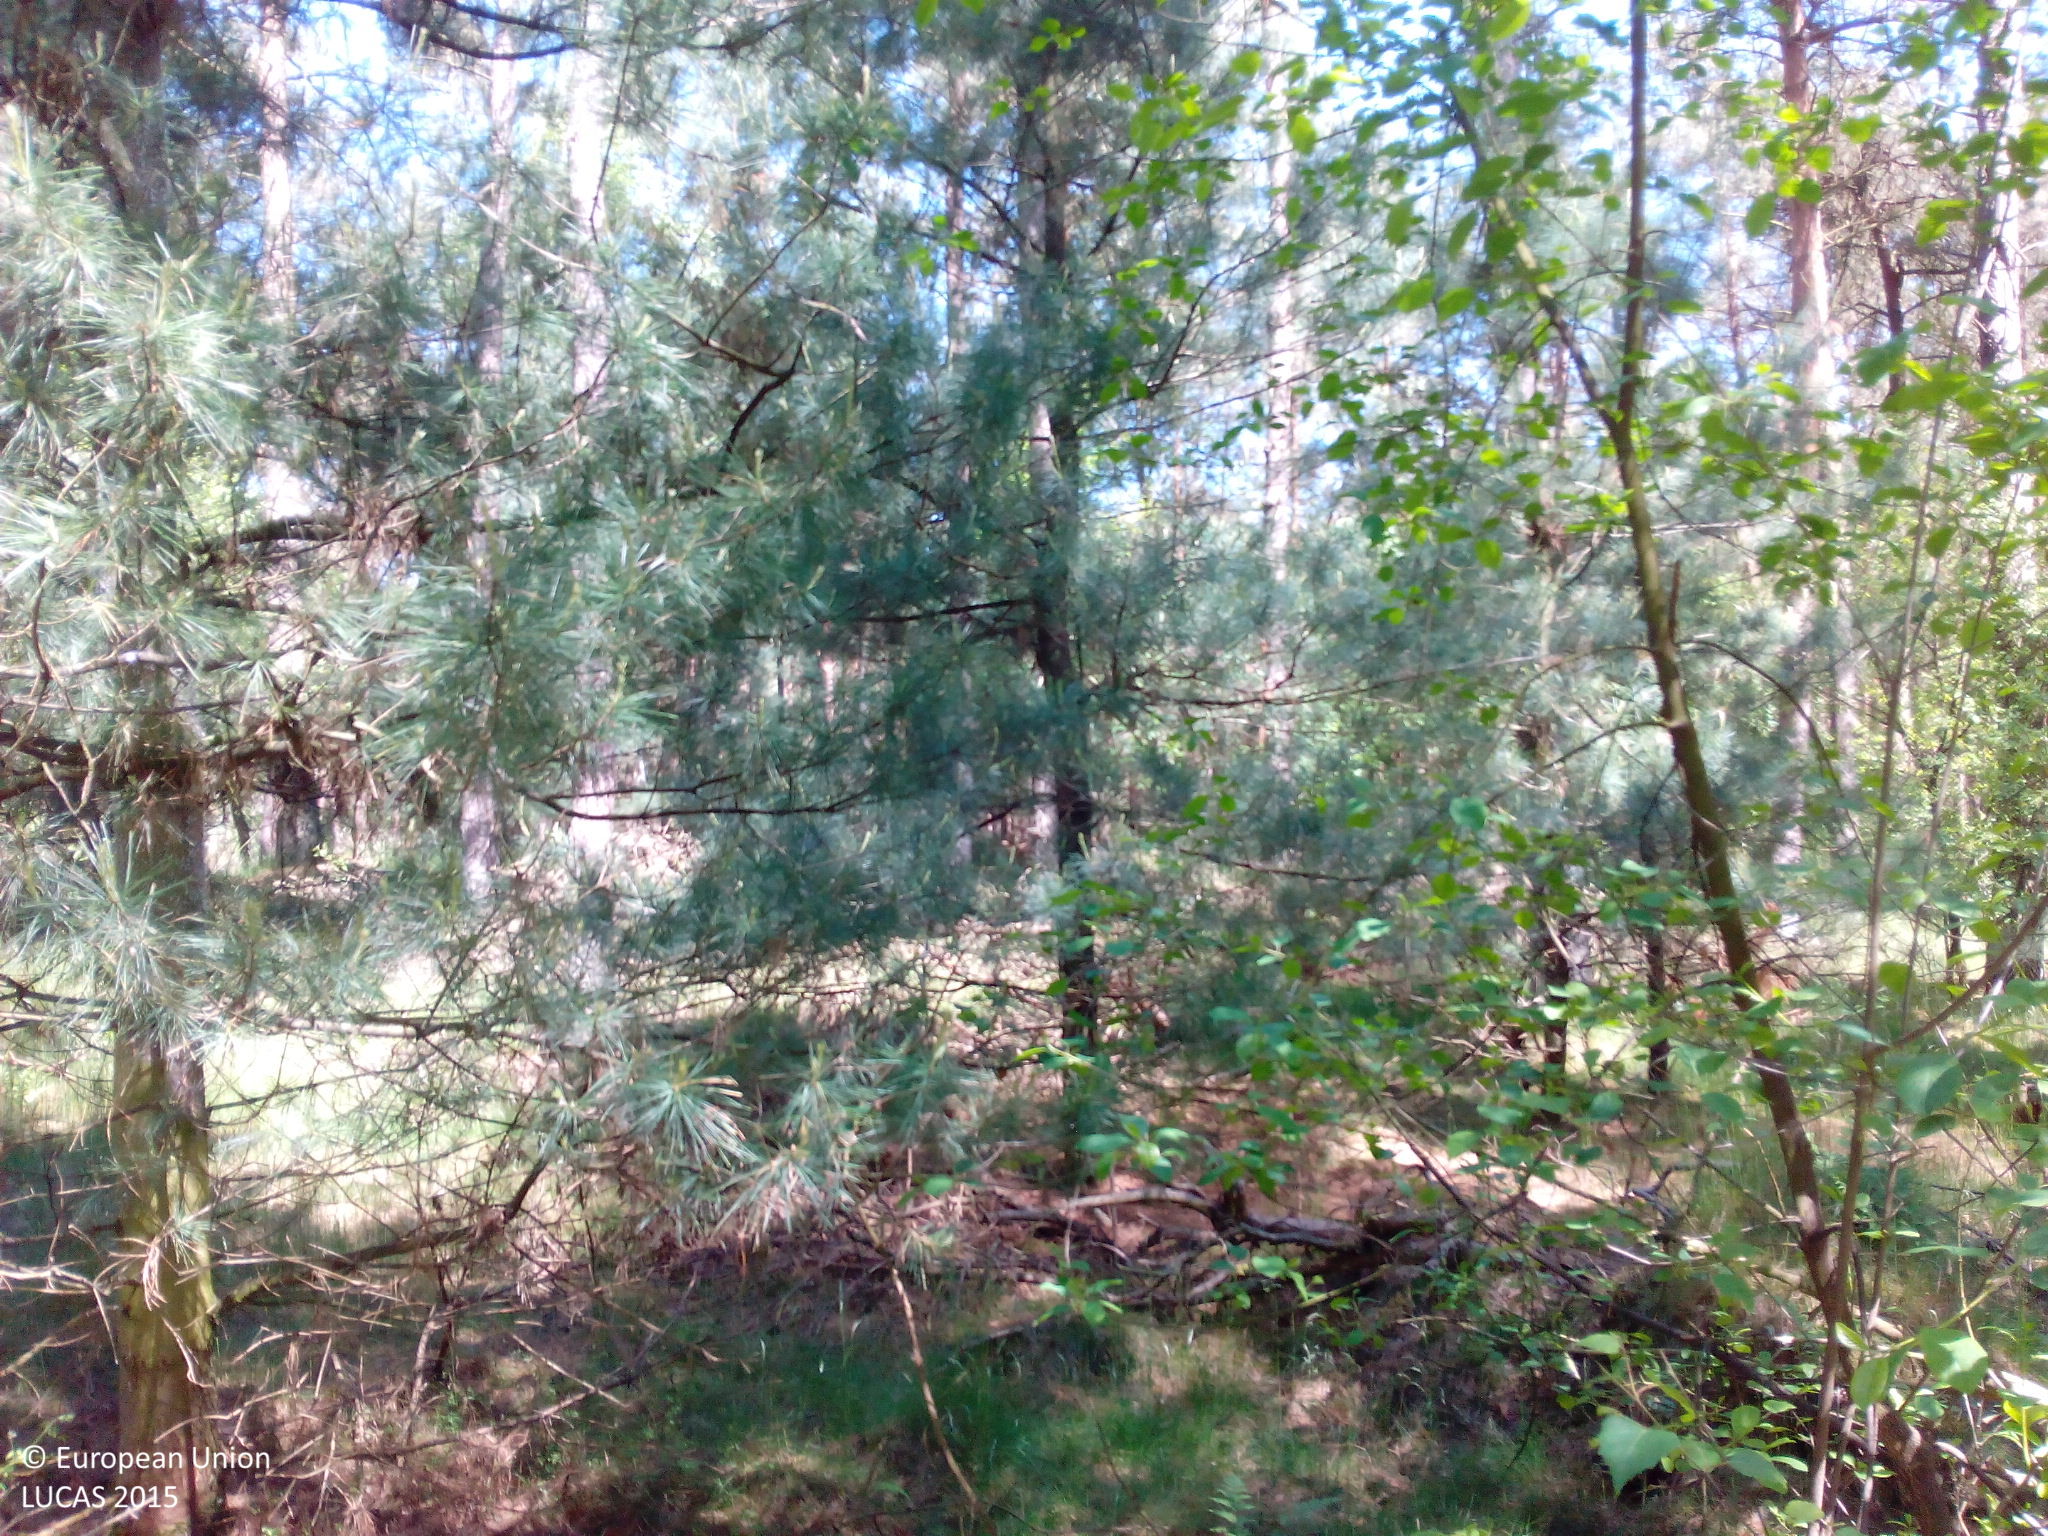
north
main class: Woodland
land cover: Pine dominated mixed woodland
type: hemiboreal forest and nemoral coniferous forest and mixed broadleaved-coniferous forest
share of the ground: > 75 %
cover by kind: coniferous forest trees 45 %, broadleaved forest trees 45 %, shrubs 5 %, herbaceous plants 5 %
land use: Forestry
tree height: > 5 m
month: June
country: DE
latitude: 52.4023
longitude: 7.3694
